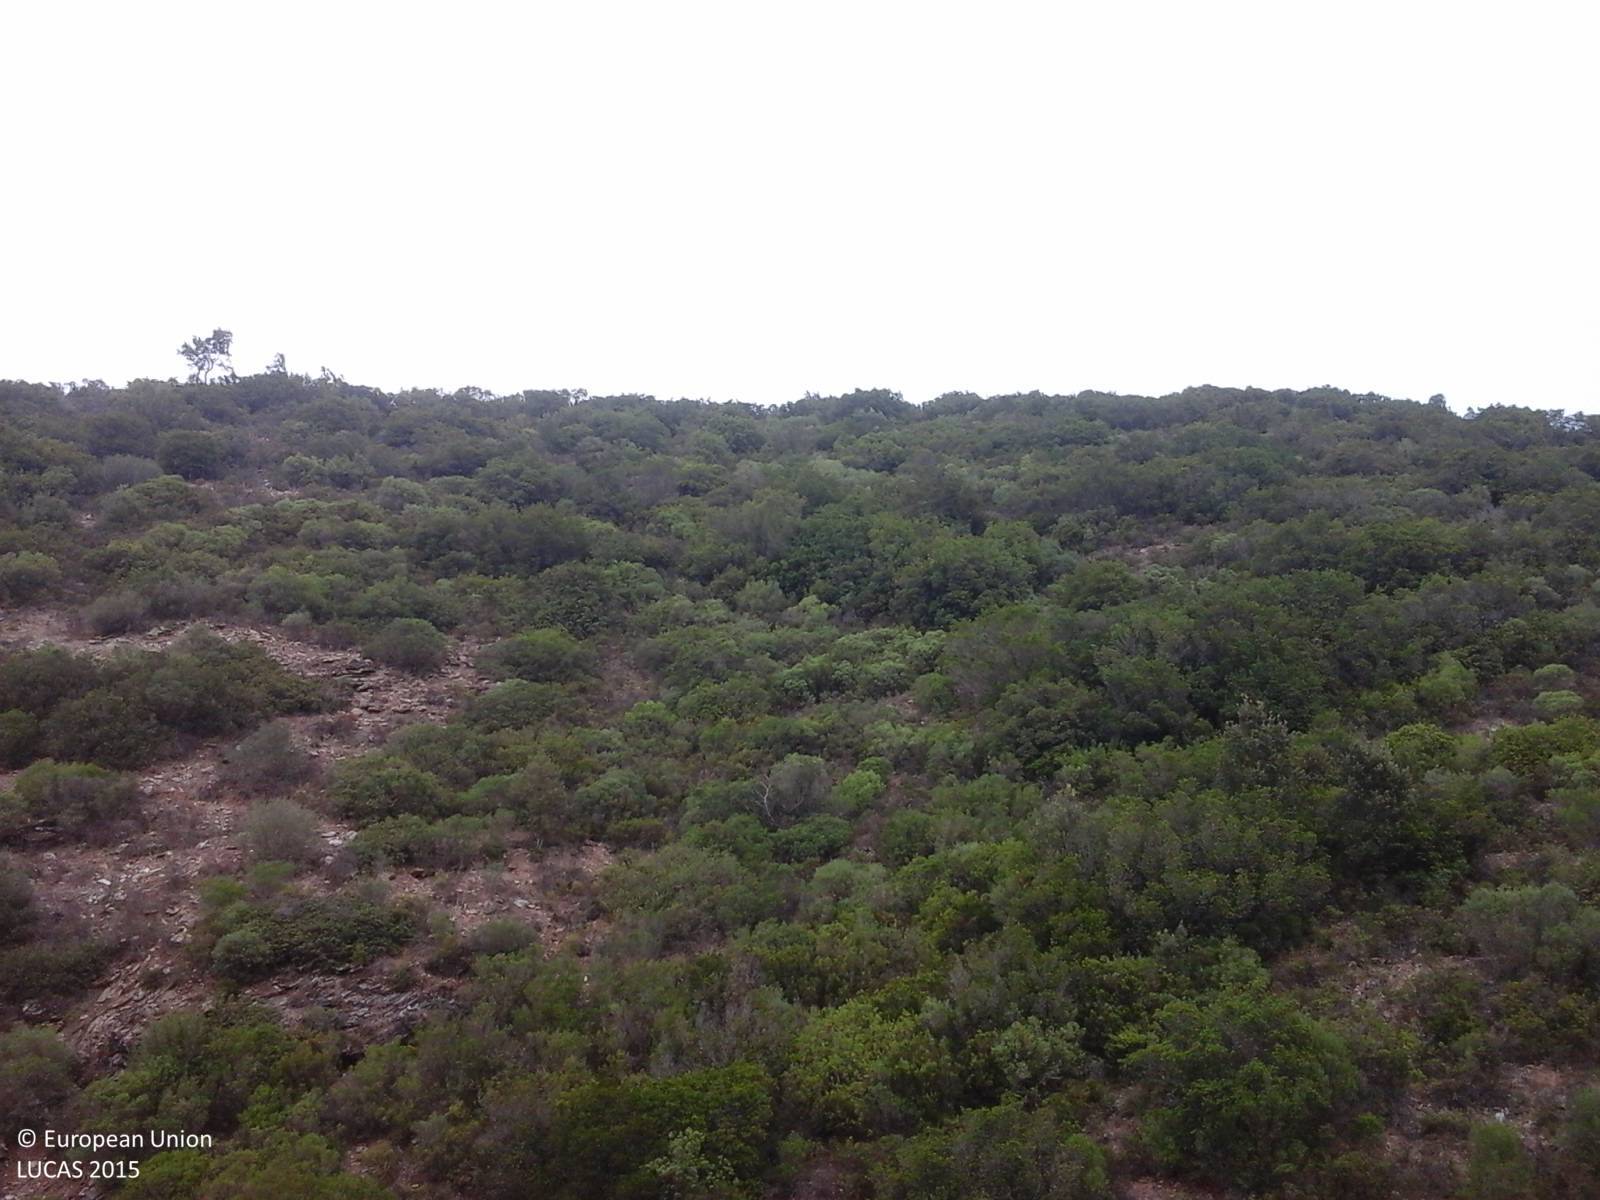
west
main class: Shrubland
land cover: Shrubland without tree cover
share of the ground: > 75 %
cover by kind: shrubs 55 %, herbaceous plants 25 %, consolidated bare surface 10 %, unconsolidated bare surface 10 %
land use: Semi-natural and natural areas not in use
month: September
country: IT
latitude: 39.7587
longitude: 9.4313
